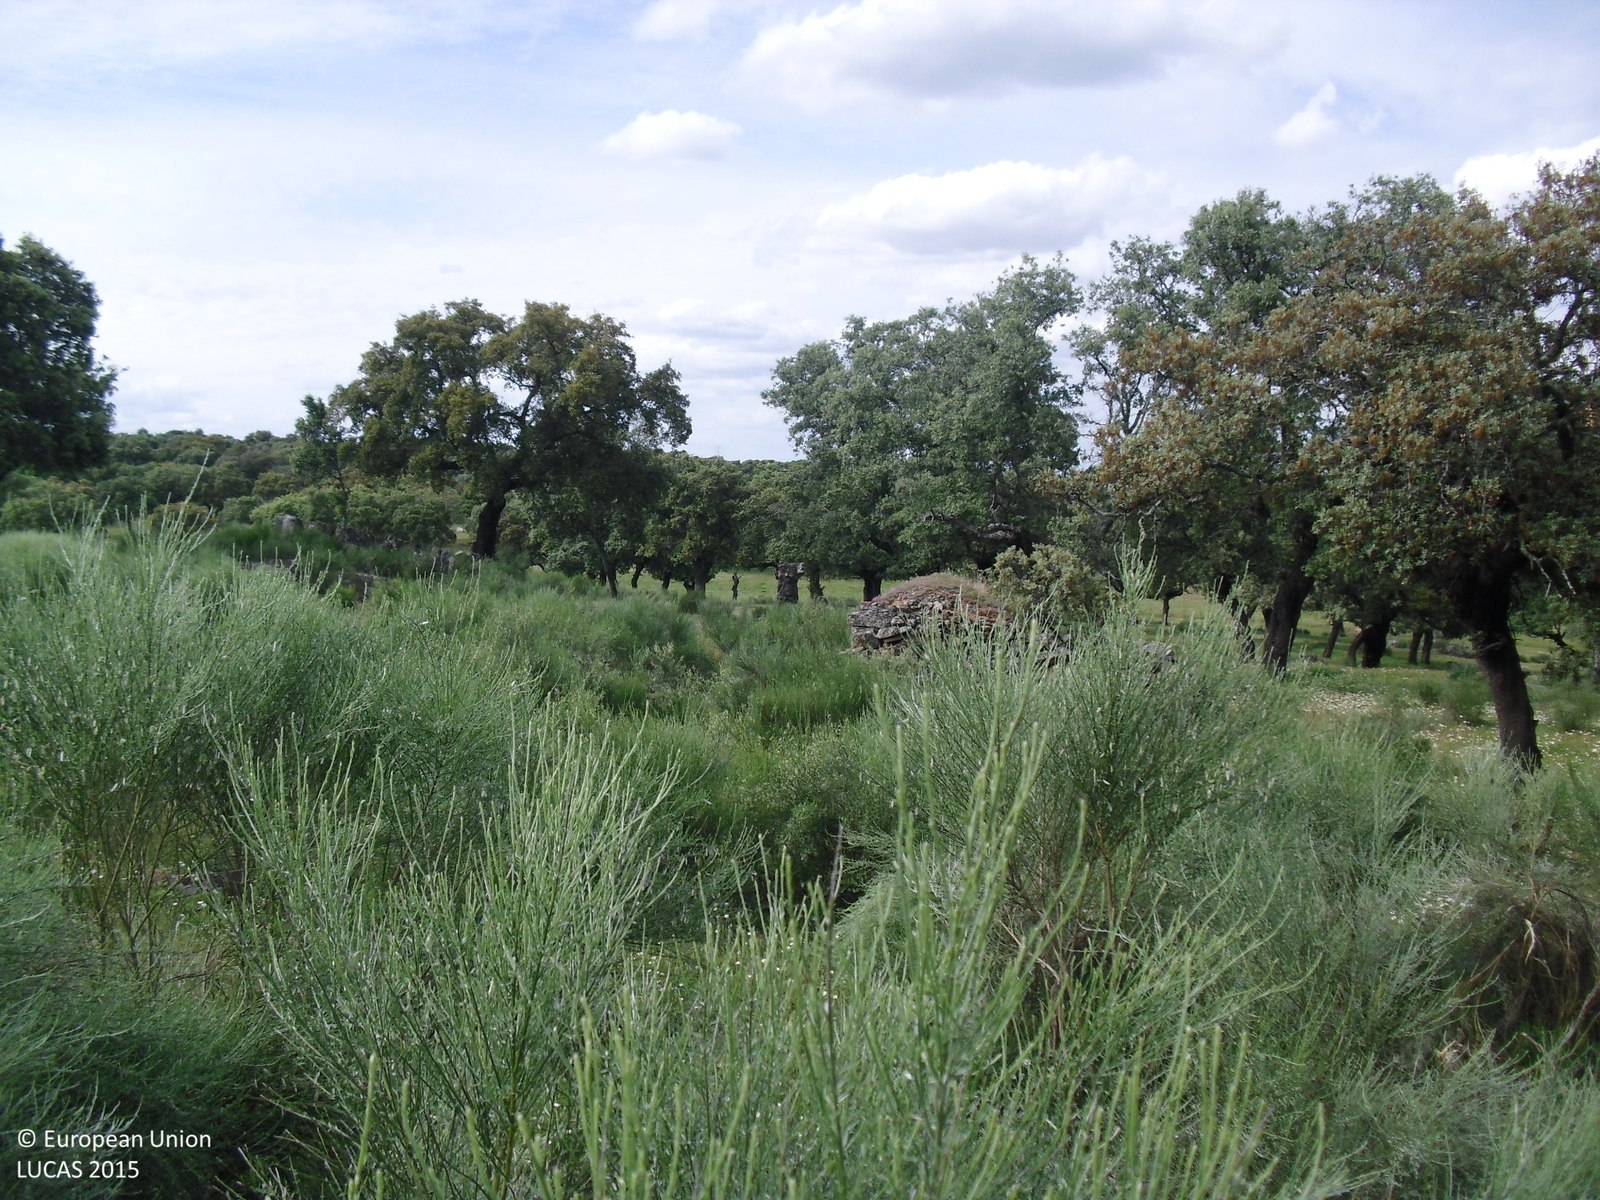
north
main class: Shrubland
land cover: Shrubland with sparse tree cover
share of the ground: > 75 %
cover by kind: shrubs 75 %, herbaceous plants 20 %, broadleaved forest trees 5 %
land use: Agriculture (excluding fallow land and kitchen gardens)
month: April
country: ES
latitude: 39.2942
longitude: -6.0005
